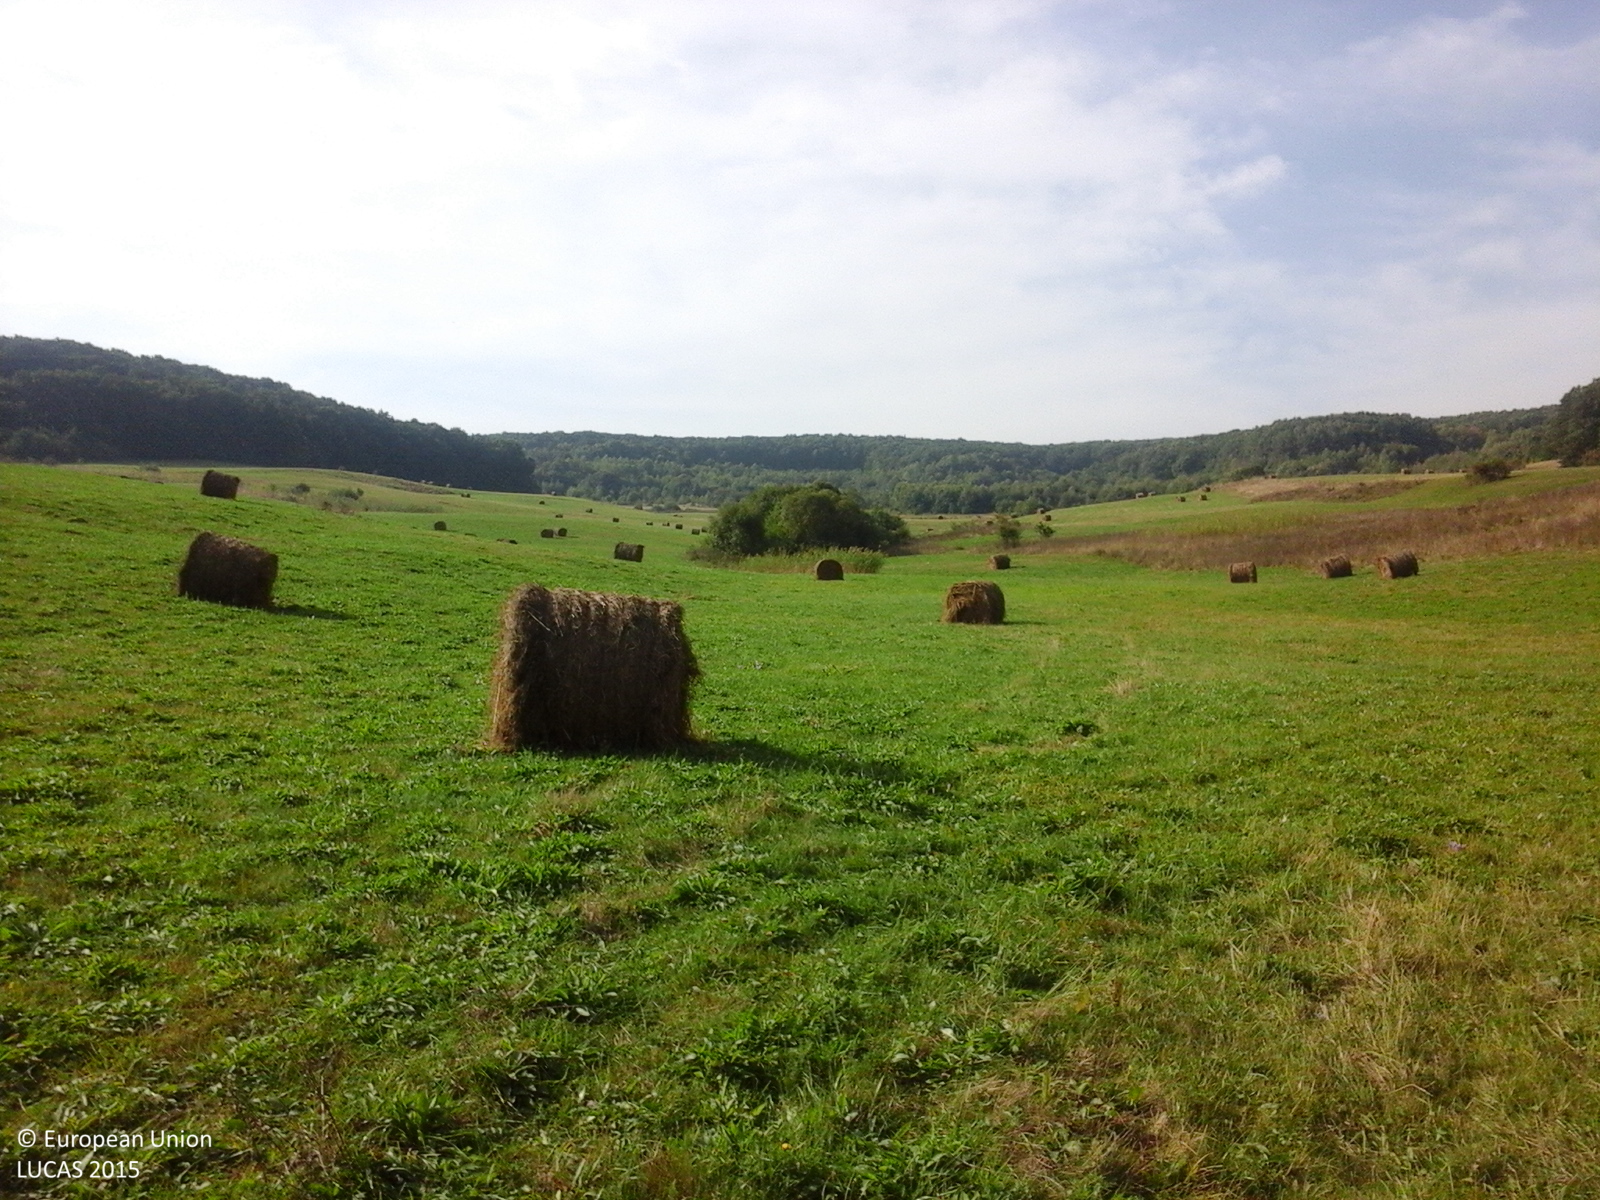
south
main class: Grassland
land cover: Grassland without tree/shrub cover
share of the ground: > 75 %
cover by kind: herbaceous plants 100 %
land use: Agriculture (excluding fallow land and kitchen gardens)
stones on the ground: < 10 %
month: September
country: RO
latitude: 46.8817
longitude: 23.4673
